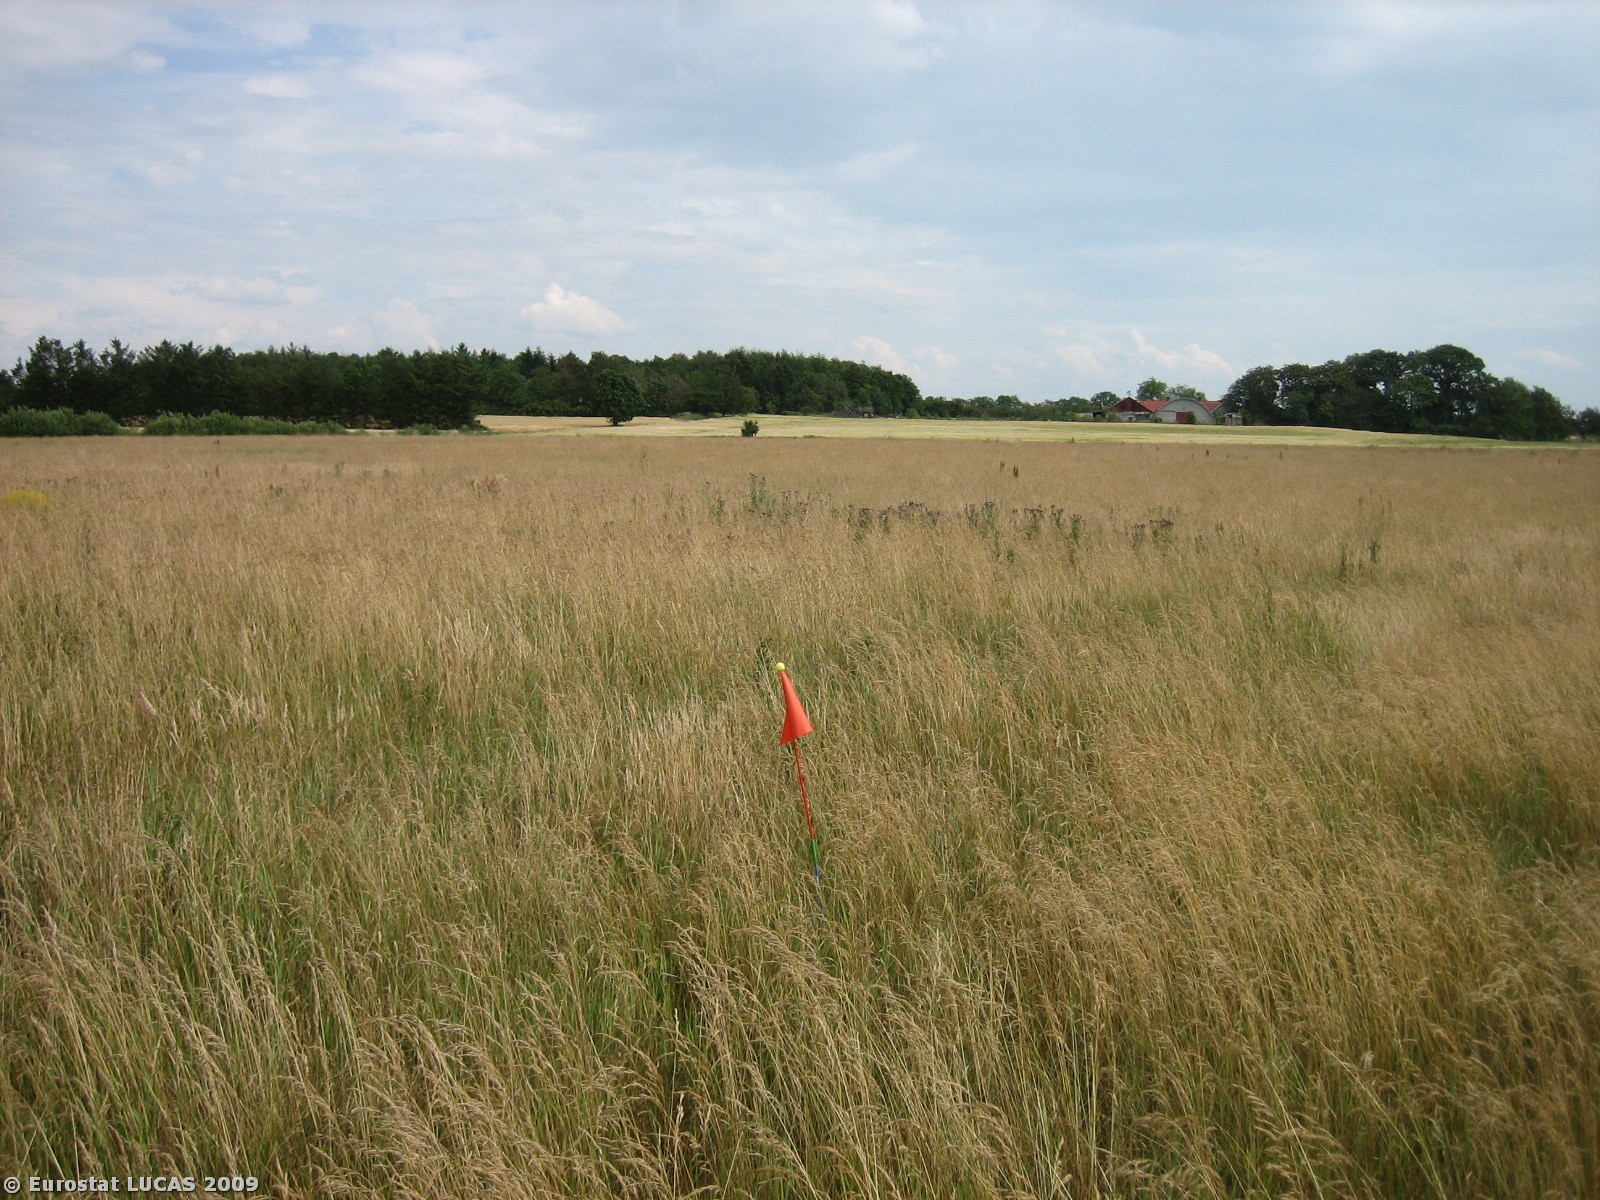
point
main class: Grassland
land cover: Grassland without tree/shrub cover
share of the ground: > 75 %
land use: Fallow land
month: July
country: DK
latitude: 55.8945
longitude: 8.8019
